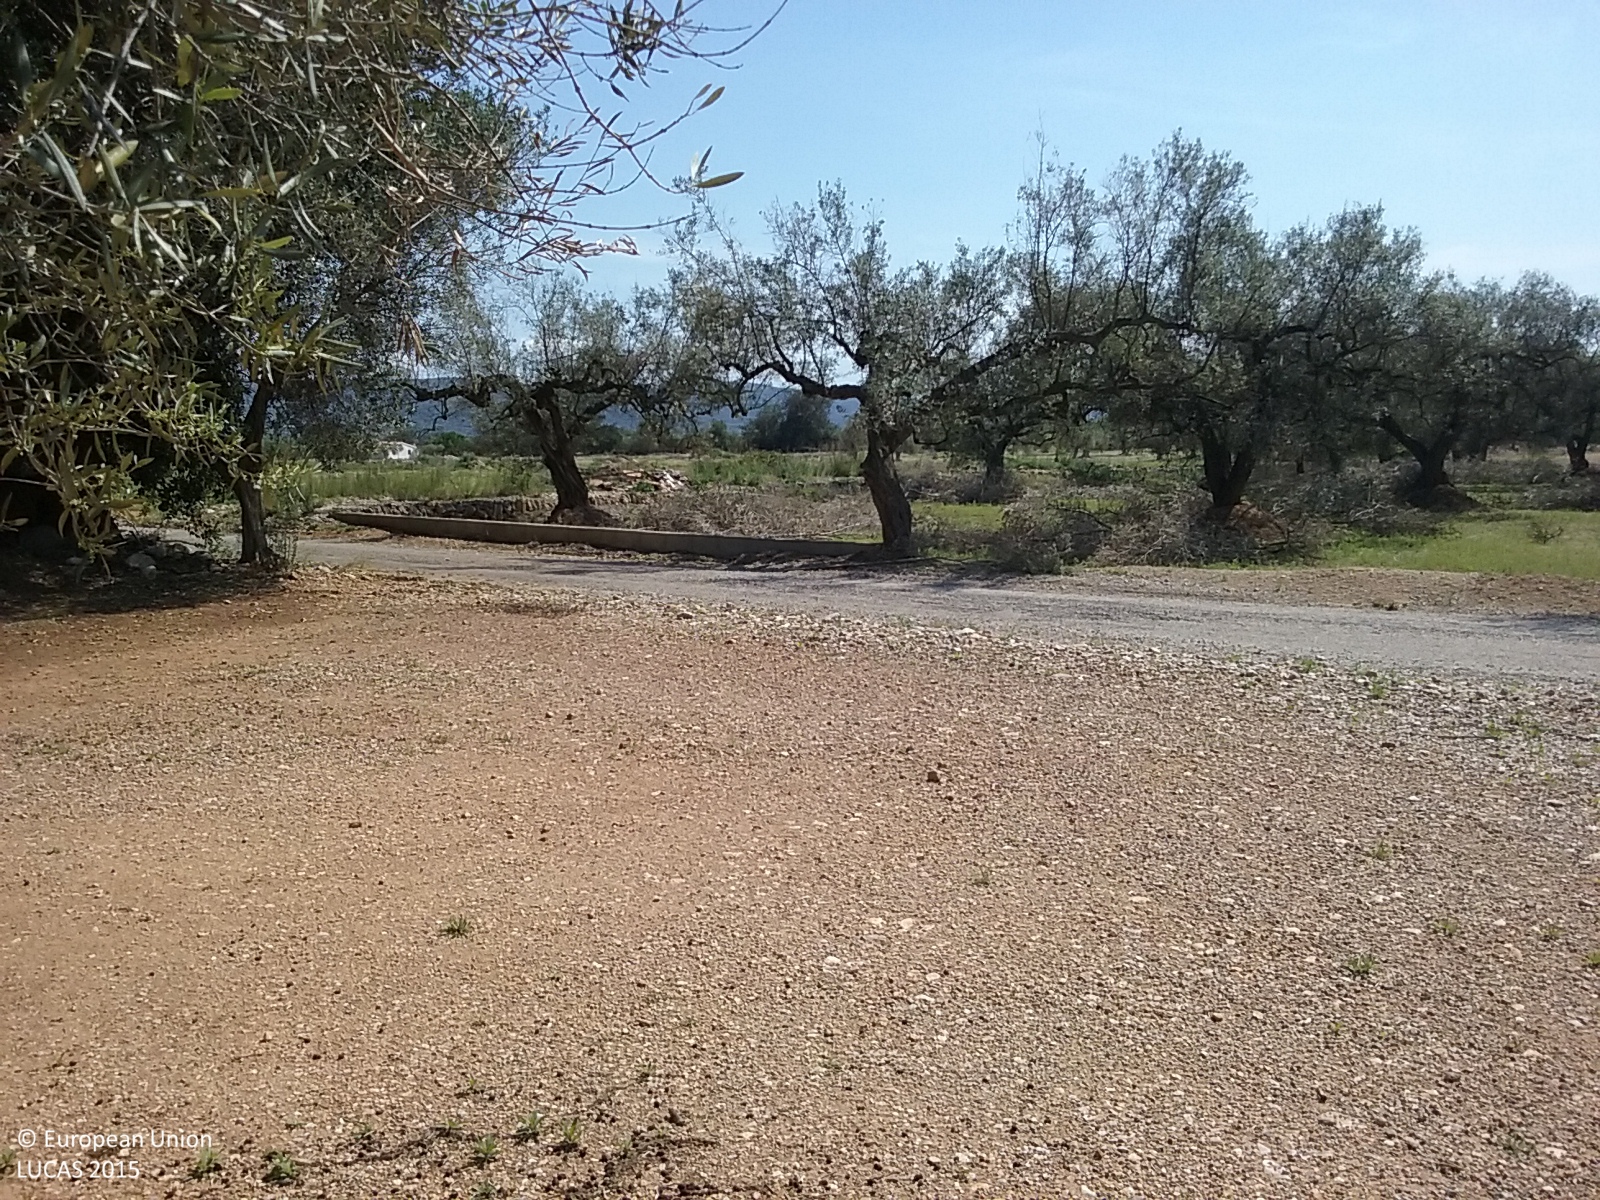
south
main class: Cropland
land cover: Olive groves
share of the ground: 10 - 25 %
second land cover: Other bare soil
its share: > 75 %
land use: Agriculture (excluding fallow land and kitchen gardens)
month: April
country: ES
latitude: 40.6919
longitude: 0.4449
